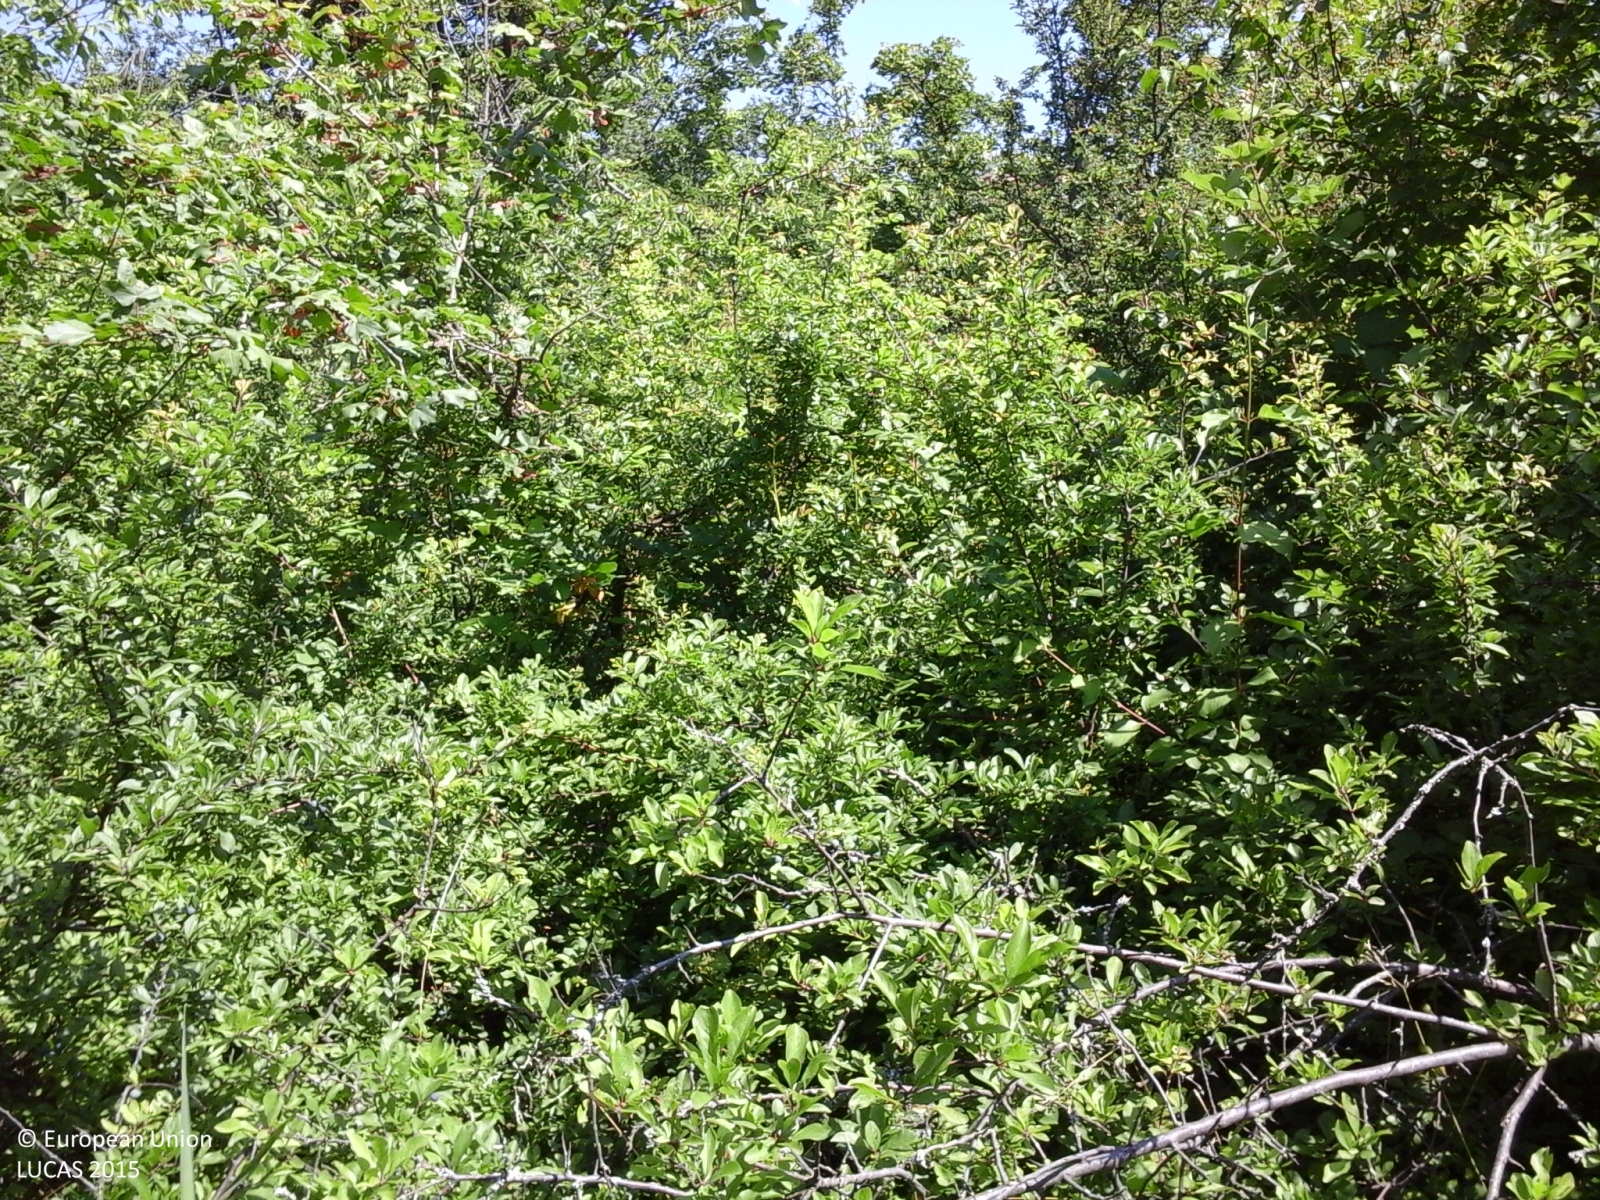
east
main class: Woodland
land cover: Broadleaved woodland
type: thermophilous deciduous forest
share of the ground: > 75 %
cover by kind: broadleaved forest trees 75 %, shrubs 25 %
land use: Forestry
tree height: > 5 m
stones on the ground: < 10 %
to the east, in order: Broadleaved woodland; Shrubland with sparse tree cover; Inland fresh running water; Broadleaved woodland; Lucerne; Electric lines; Lucerne
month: May
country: IT
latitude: 44.7653
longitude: 10.0630
